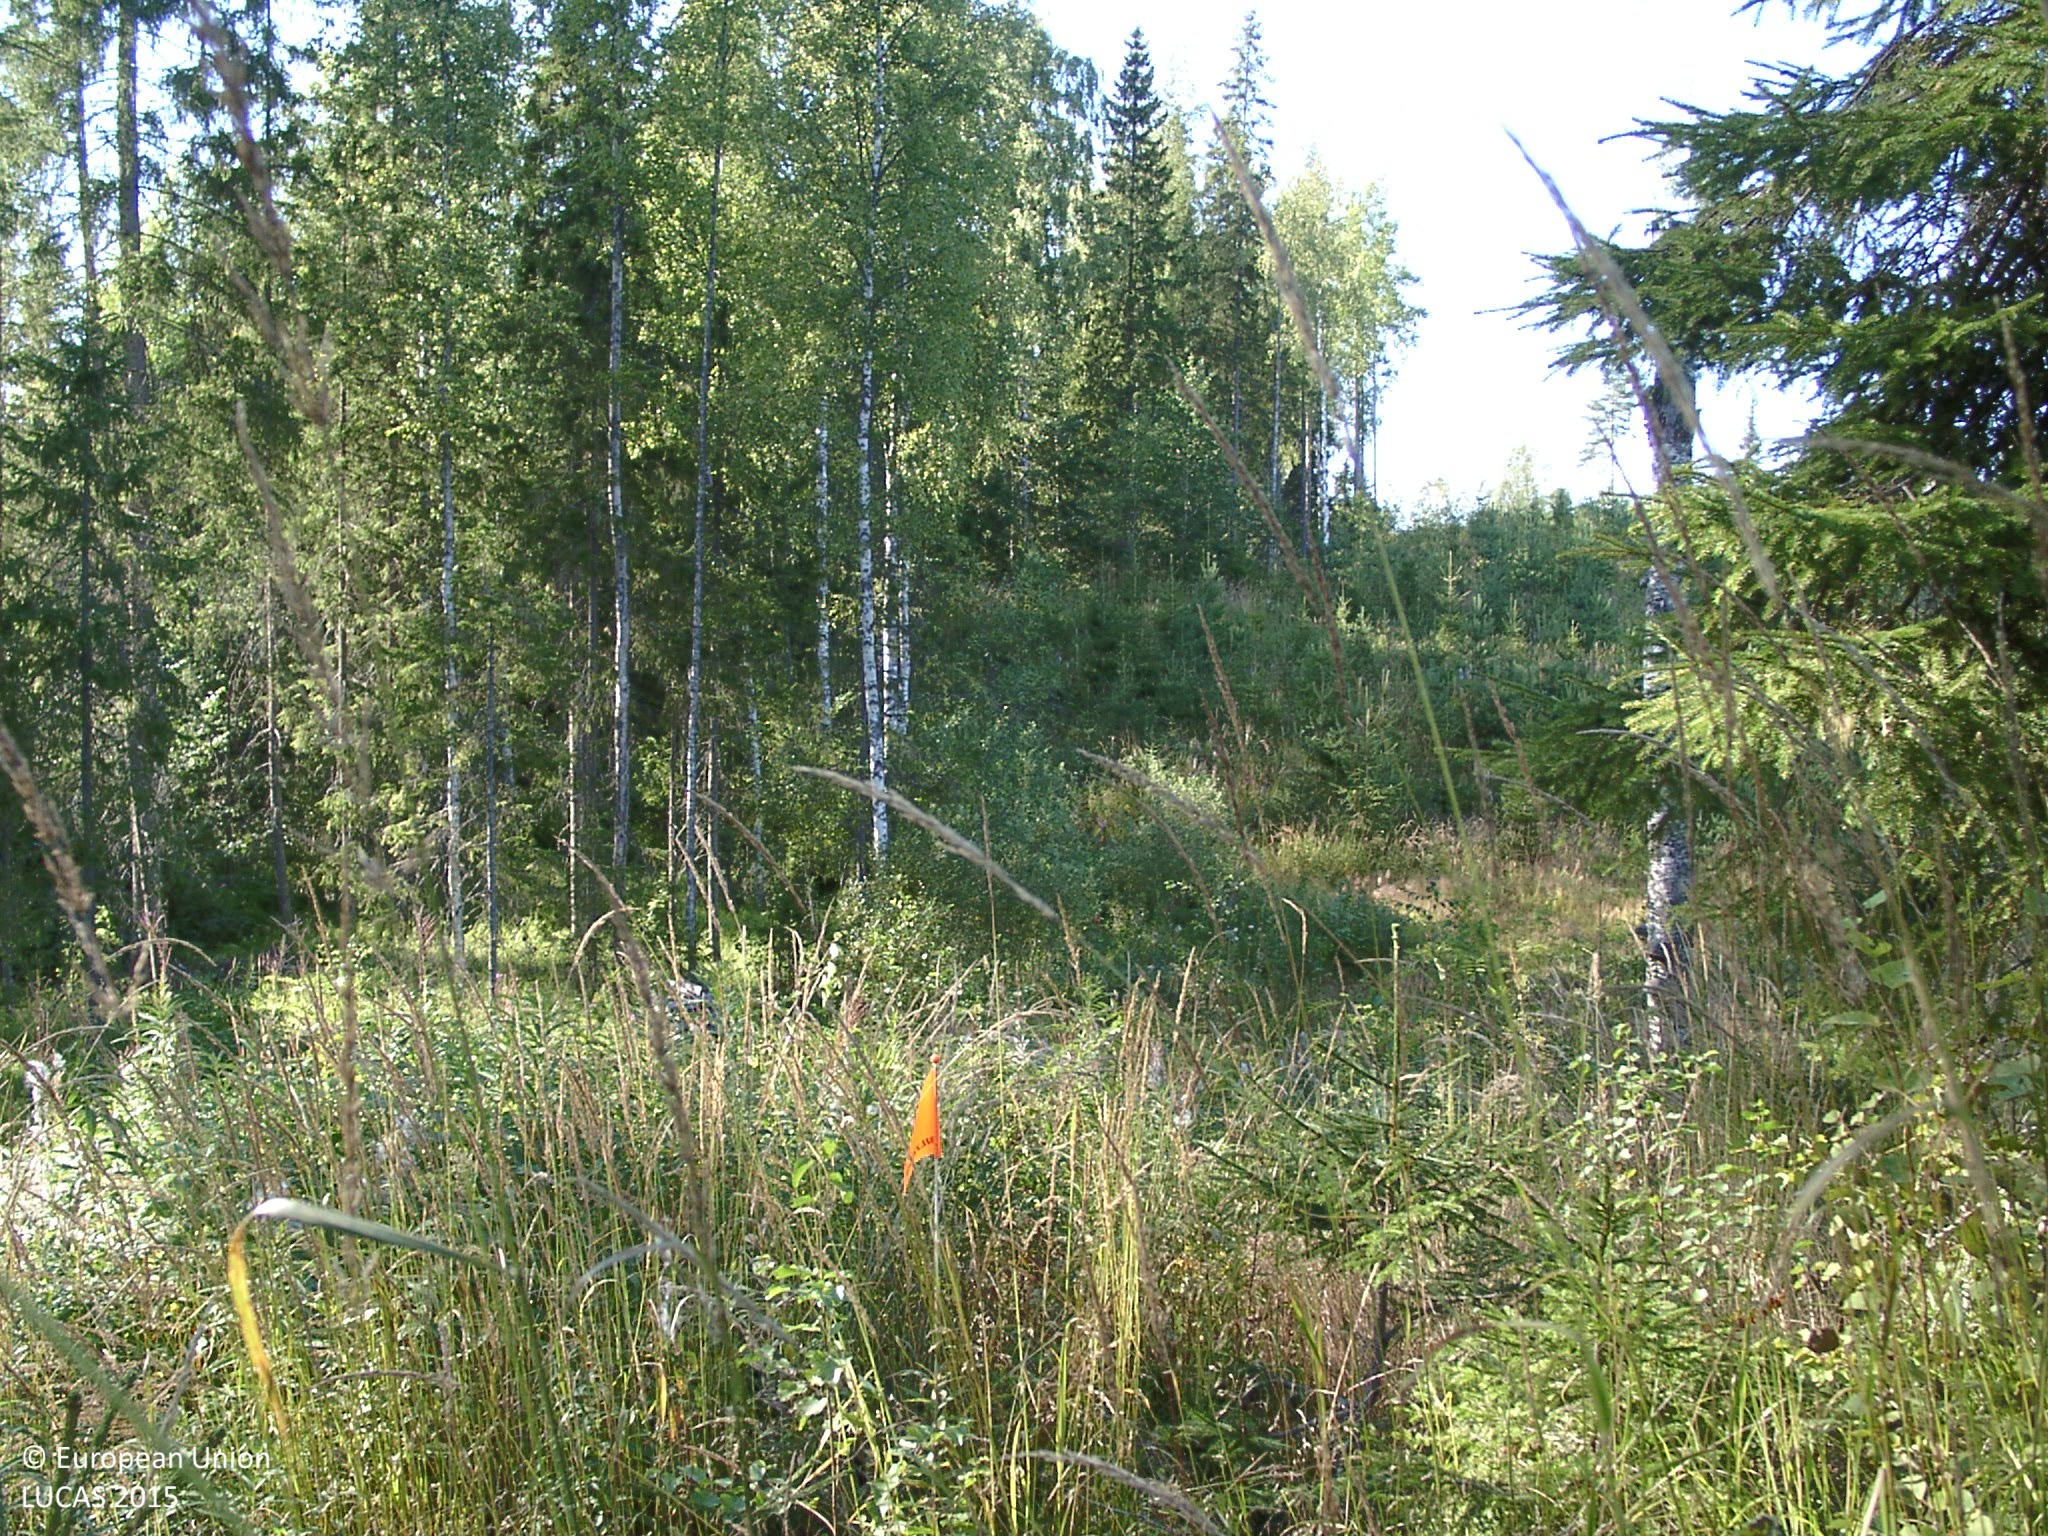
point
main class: Grassland
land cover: Grassland with sparse tree/shrub cover
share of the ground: > 75 %
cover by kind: herbaceous plants 90 %, coniferous forest trees 5 %, shrubs 5 %
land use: Forestry
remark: Clear cut
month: August
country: FI
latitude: 61.9087
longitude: 25.0119
